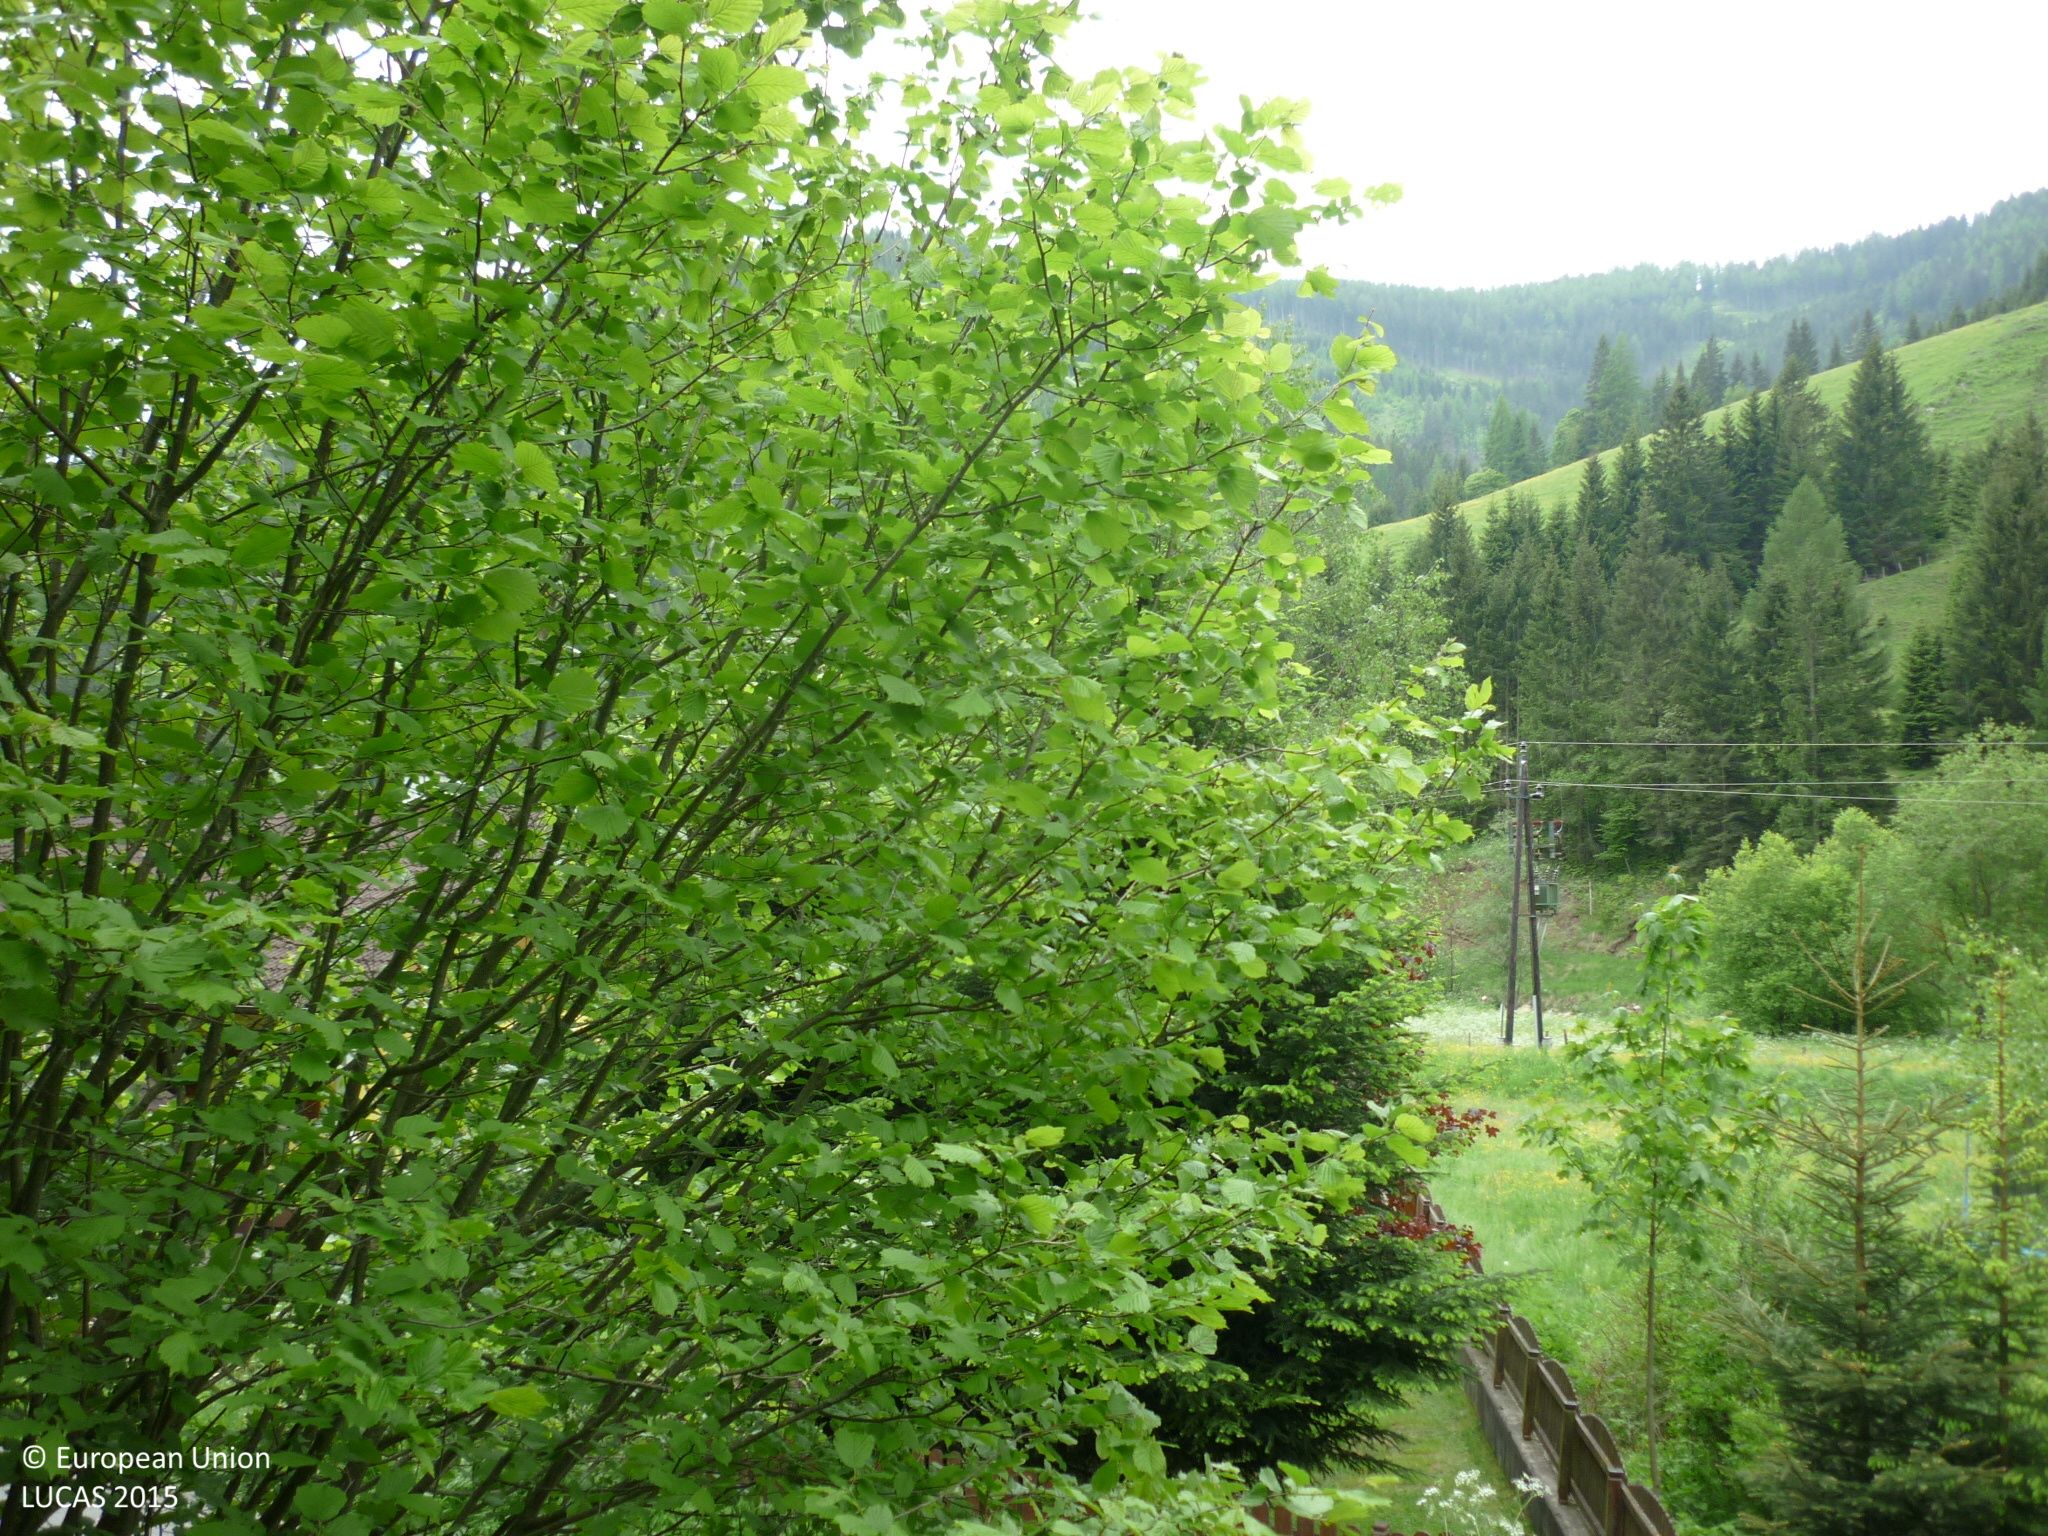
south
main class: Shrubland
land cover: Shrubland with sparse tree cover
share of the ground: 50 - 75 %
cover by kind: shrubs 50 %, herbaceous plants 25 %, consolidated bare surface 10 %, unconsolidated bare surface 10 %, coniferous forest trees 5 %
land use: Semi-natural and natural areas not in use
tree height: > 5 m
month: June
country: AT
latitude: 47.3234
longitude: 14.4312
